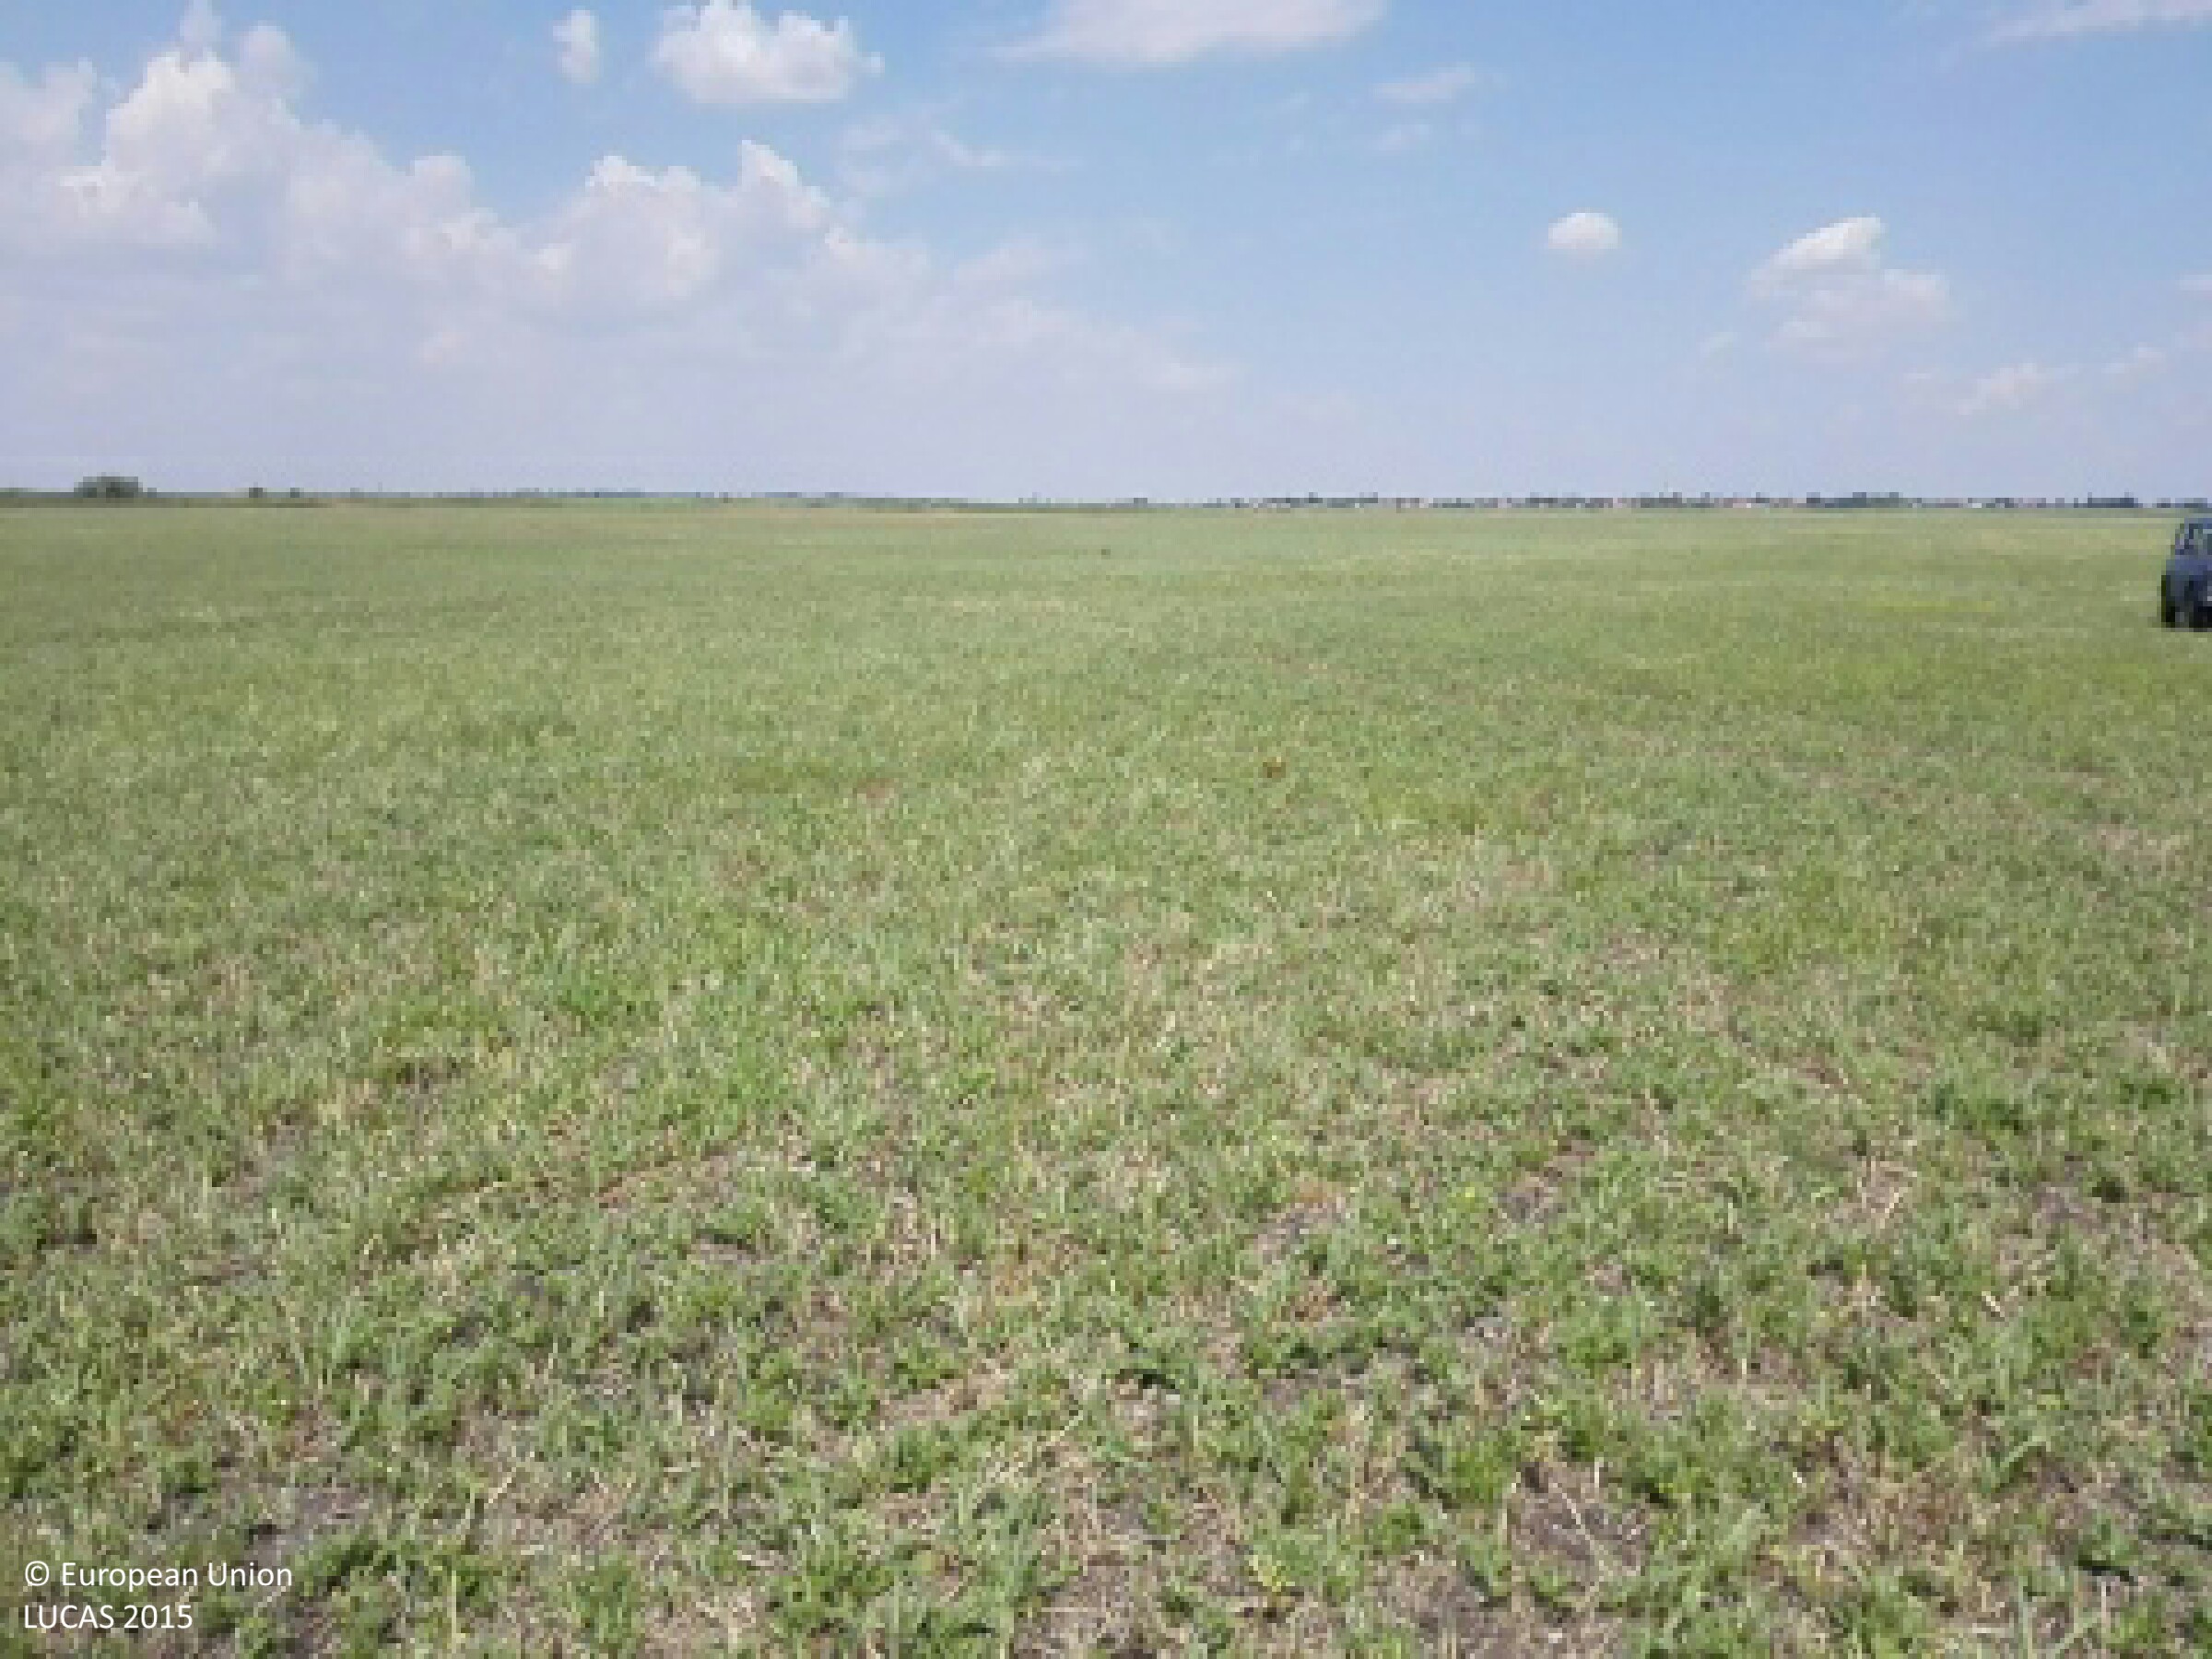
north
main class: Cropland
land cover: Other fibre and oleaginous crops
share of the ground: 50 - 75 %
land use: Agriculture (excluding fallow land and kitchen gardens)
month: July
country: HU
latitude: 47.2960
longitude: 21.2930
